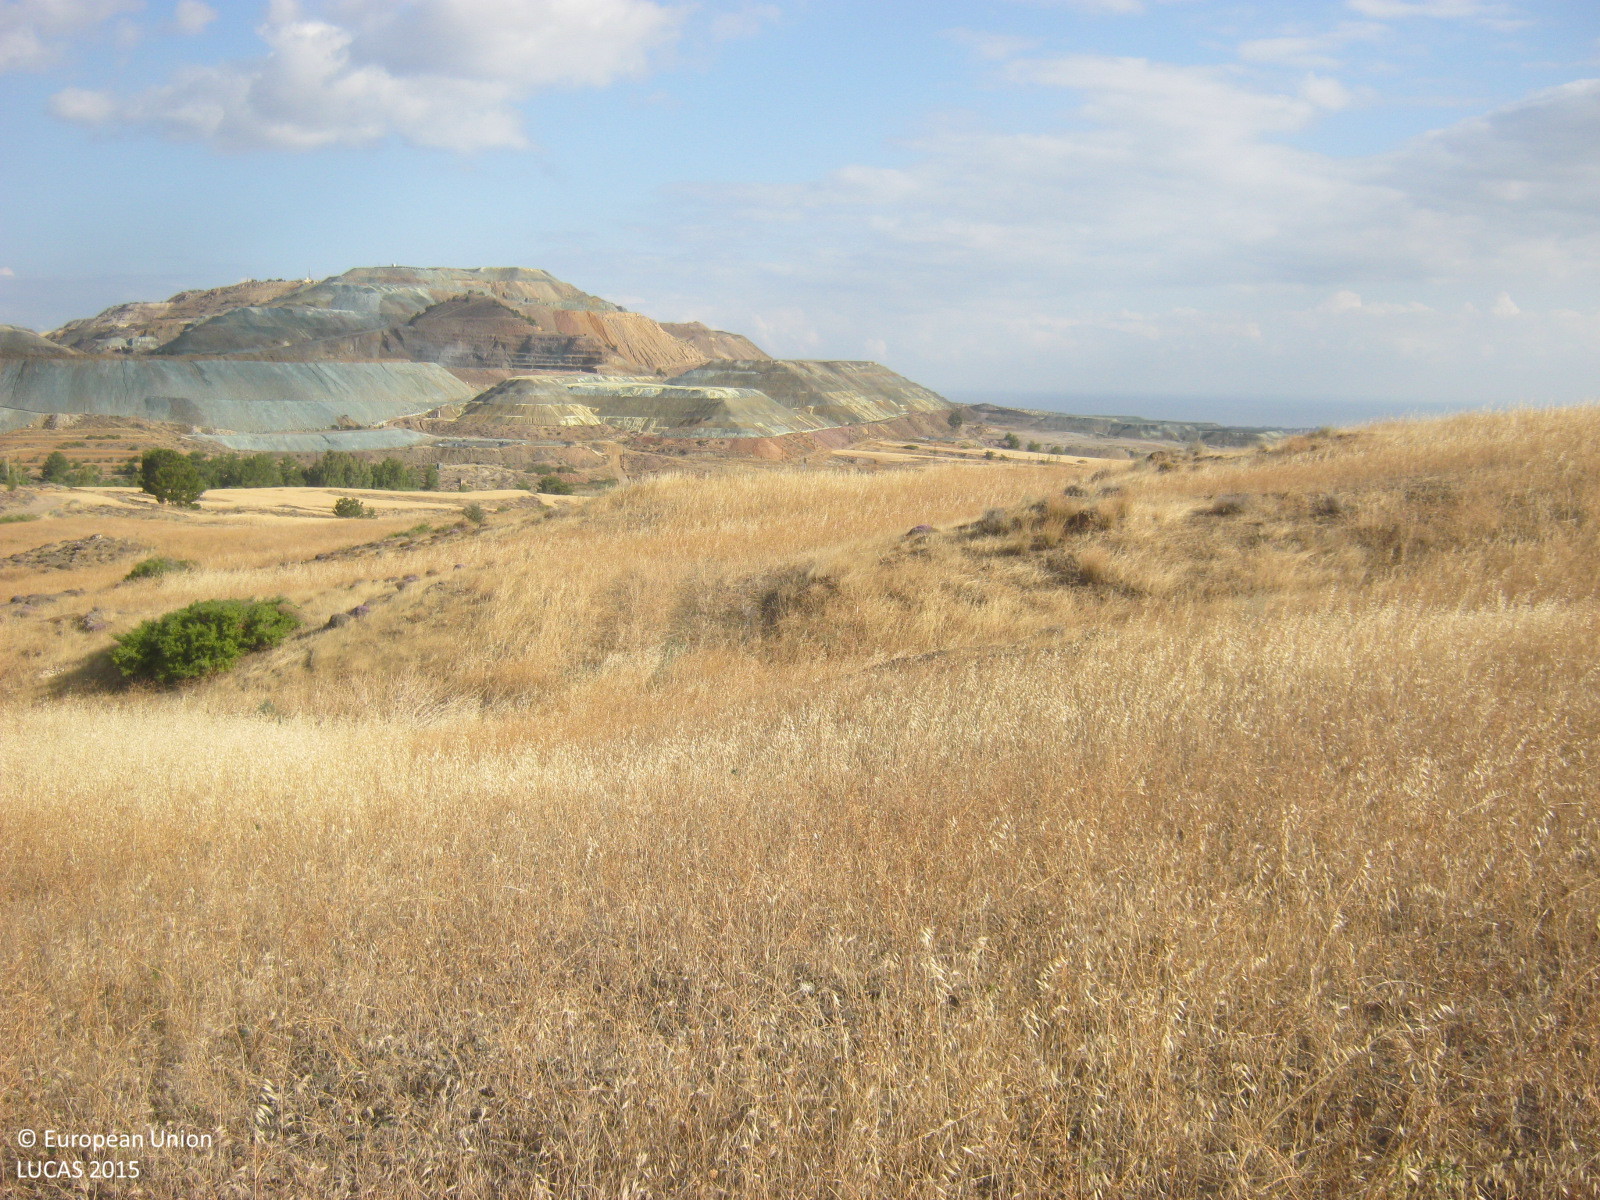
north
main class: Shrubland
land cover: Shrubland without tree cover
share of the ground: 10 - 25 %
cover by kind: herbaceous plants 70 %, shrubs 20 %, unconsolidated bare surface 10 %
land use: Semi-natural and natural areas not in use
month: June
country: CY
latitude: 35.0798
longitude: 32.9084
